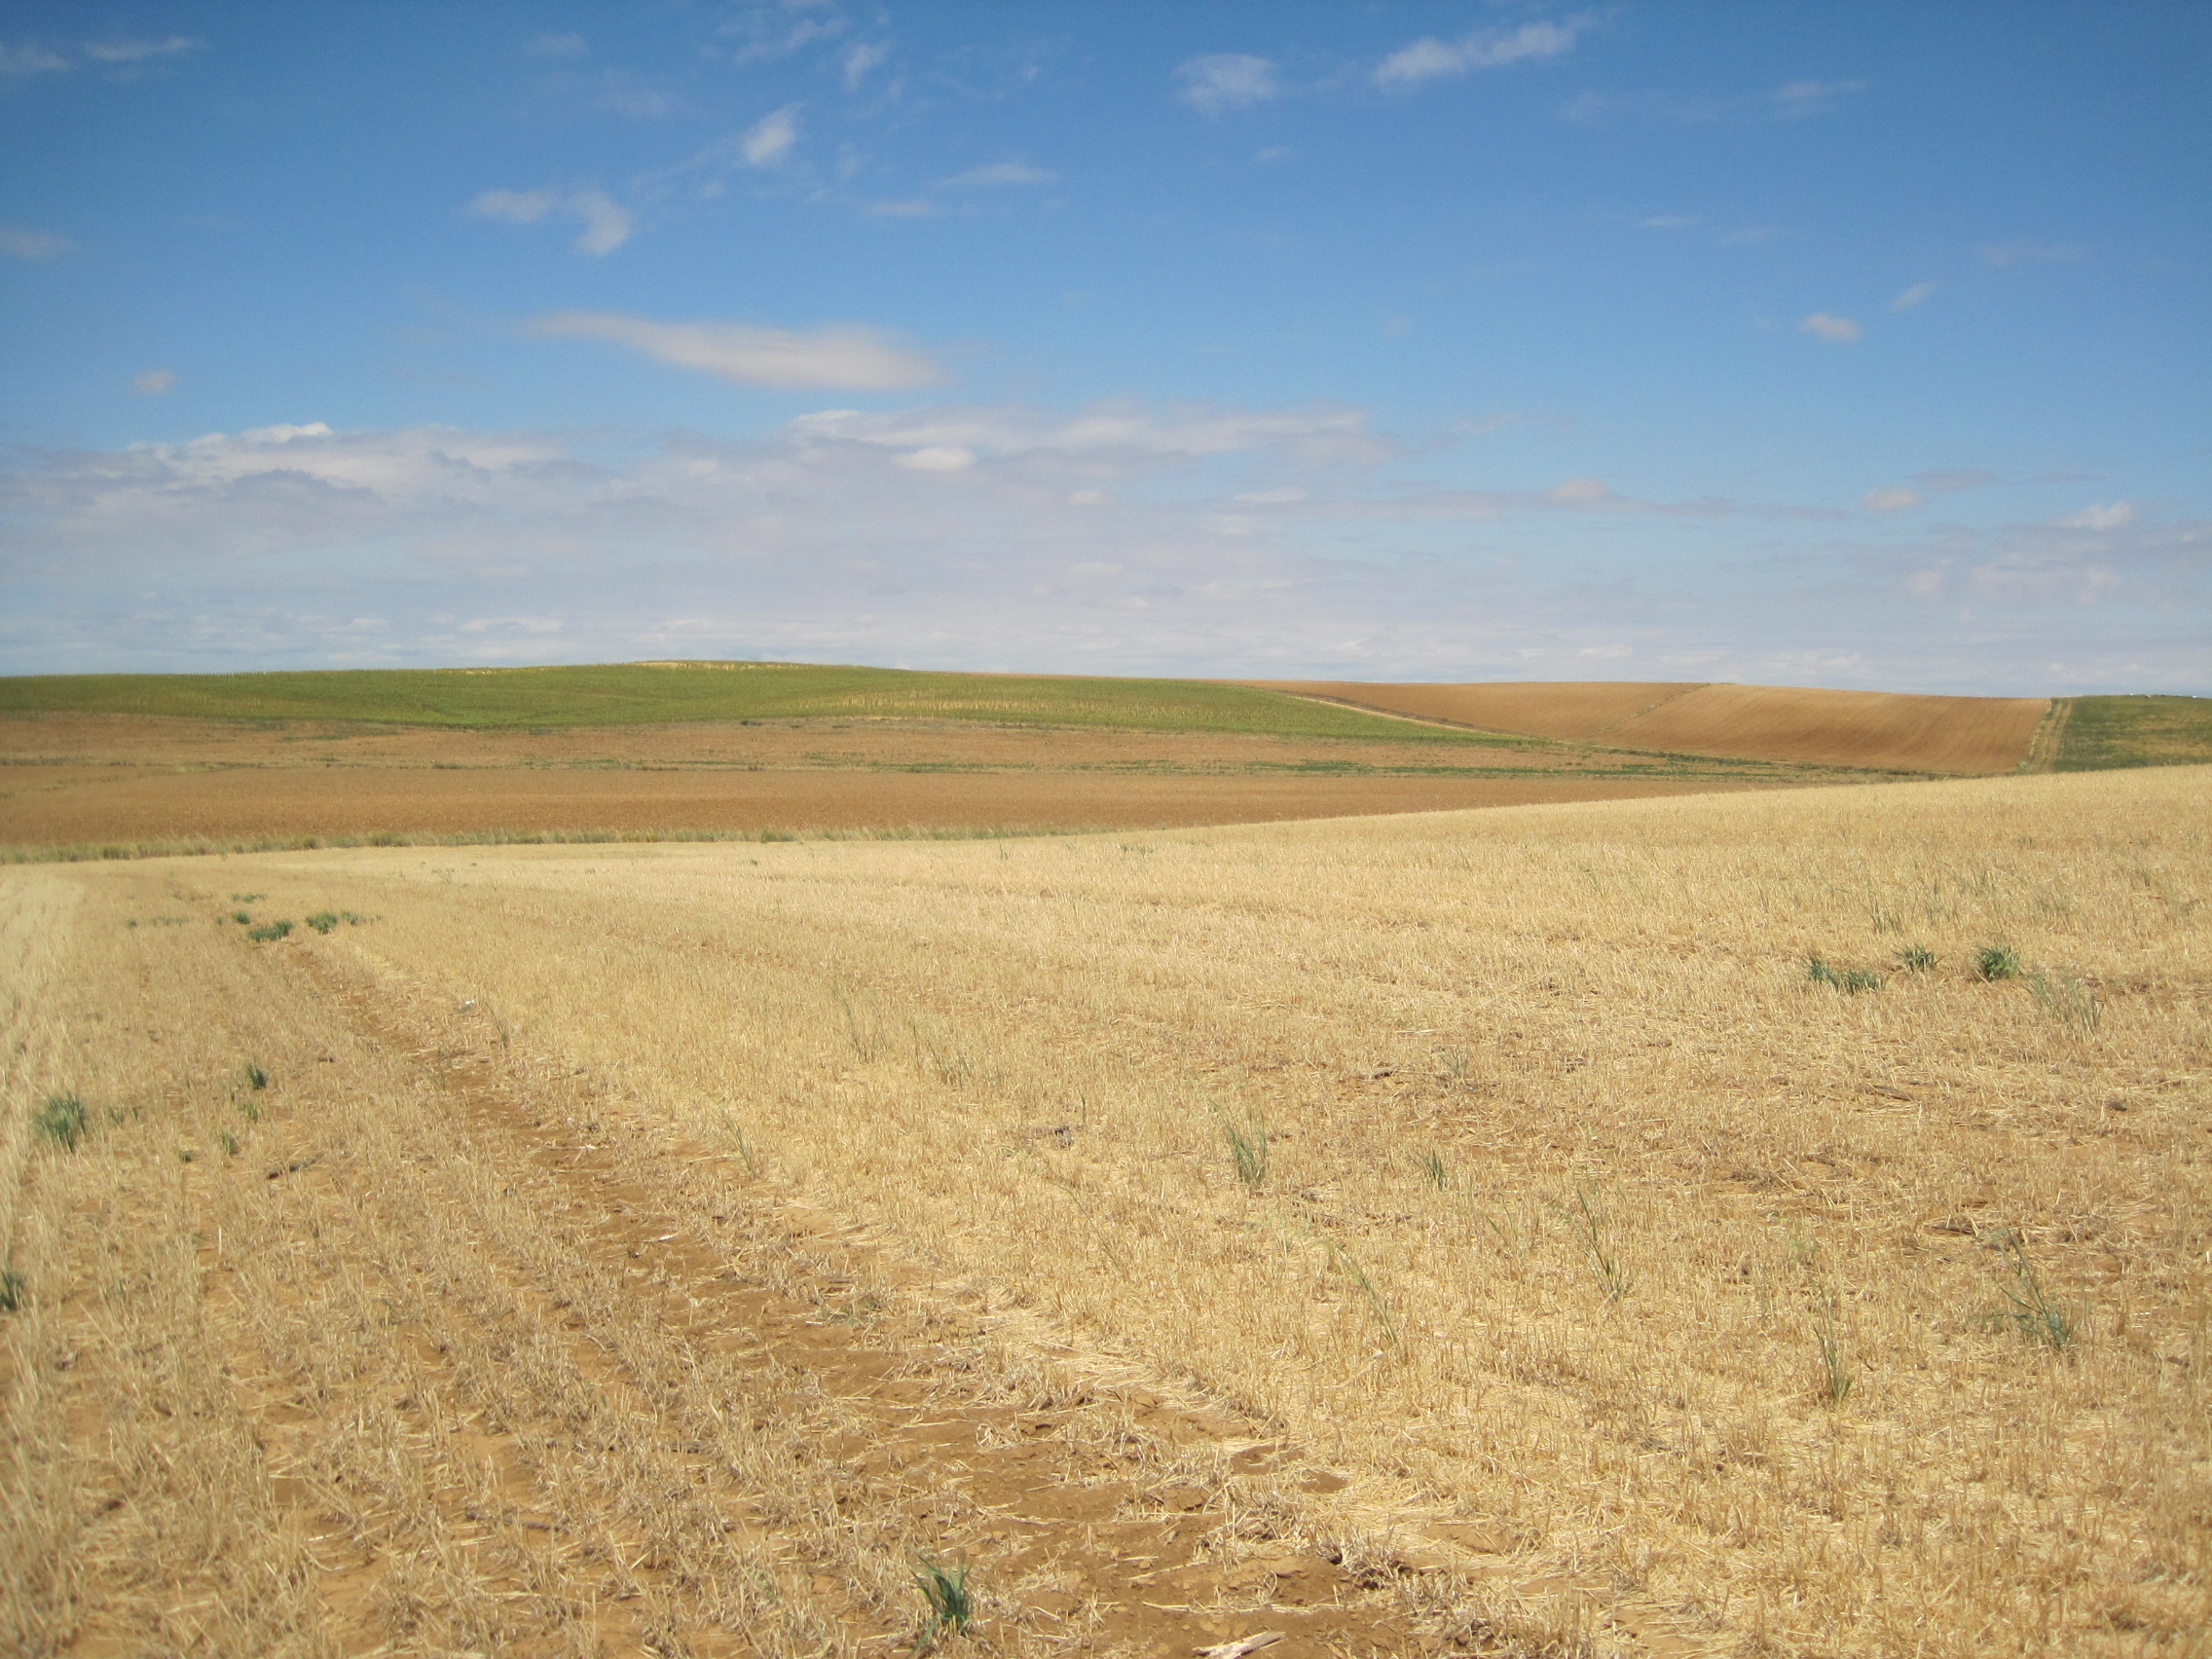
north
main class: Cropland
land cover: Barley
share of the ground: < 10 %
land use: Agriculture (excluding fallow land and kitchen gardens)
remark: Harvested field
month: July
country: ES
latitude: 42.0498
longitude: -5.1977
